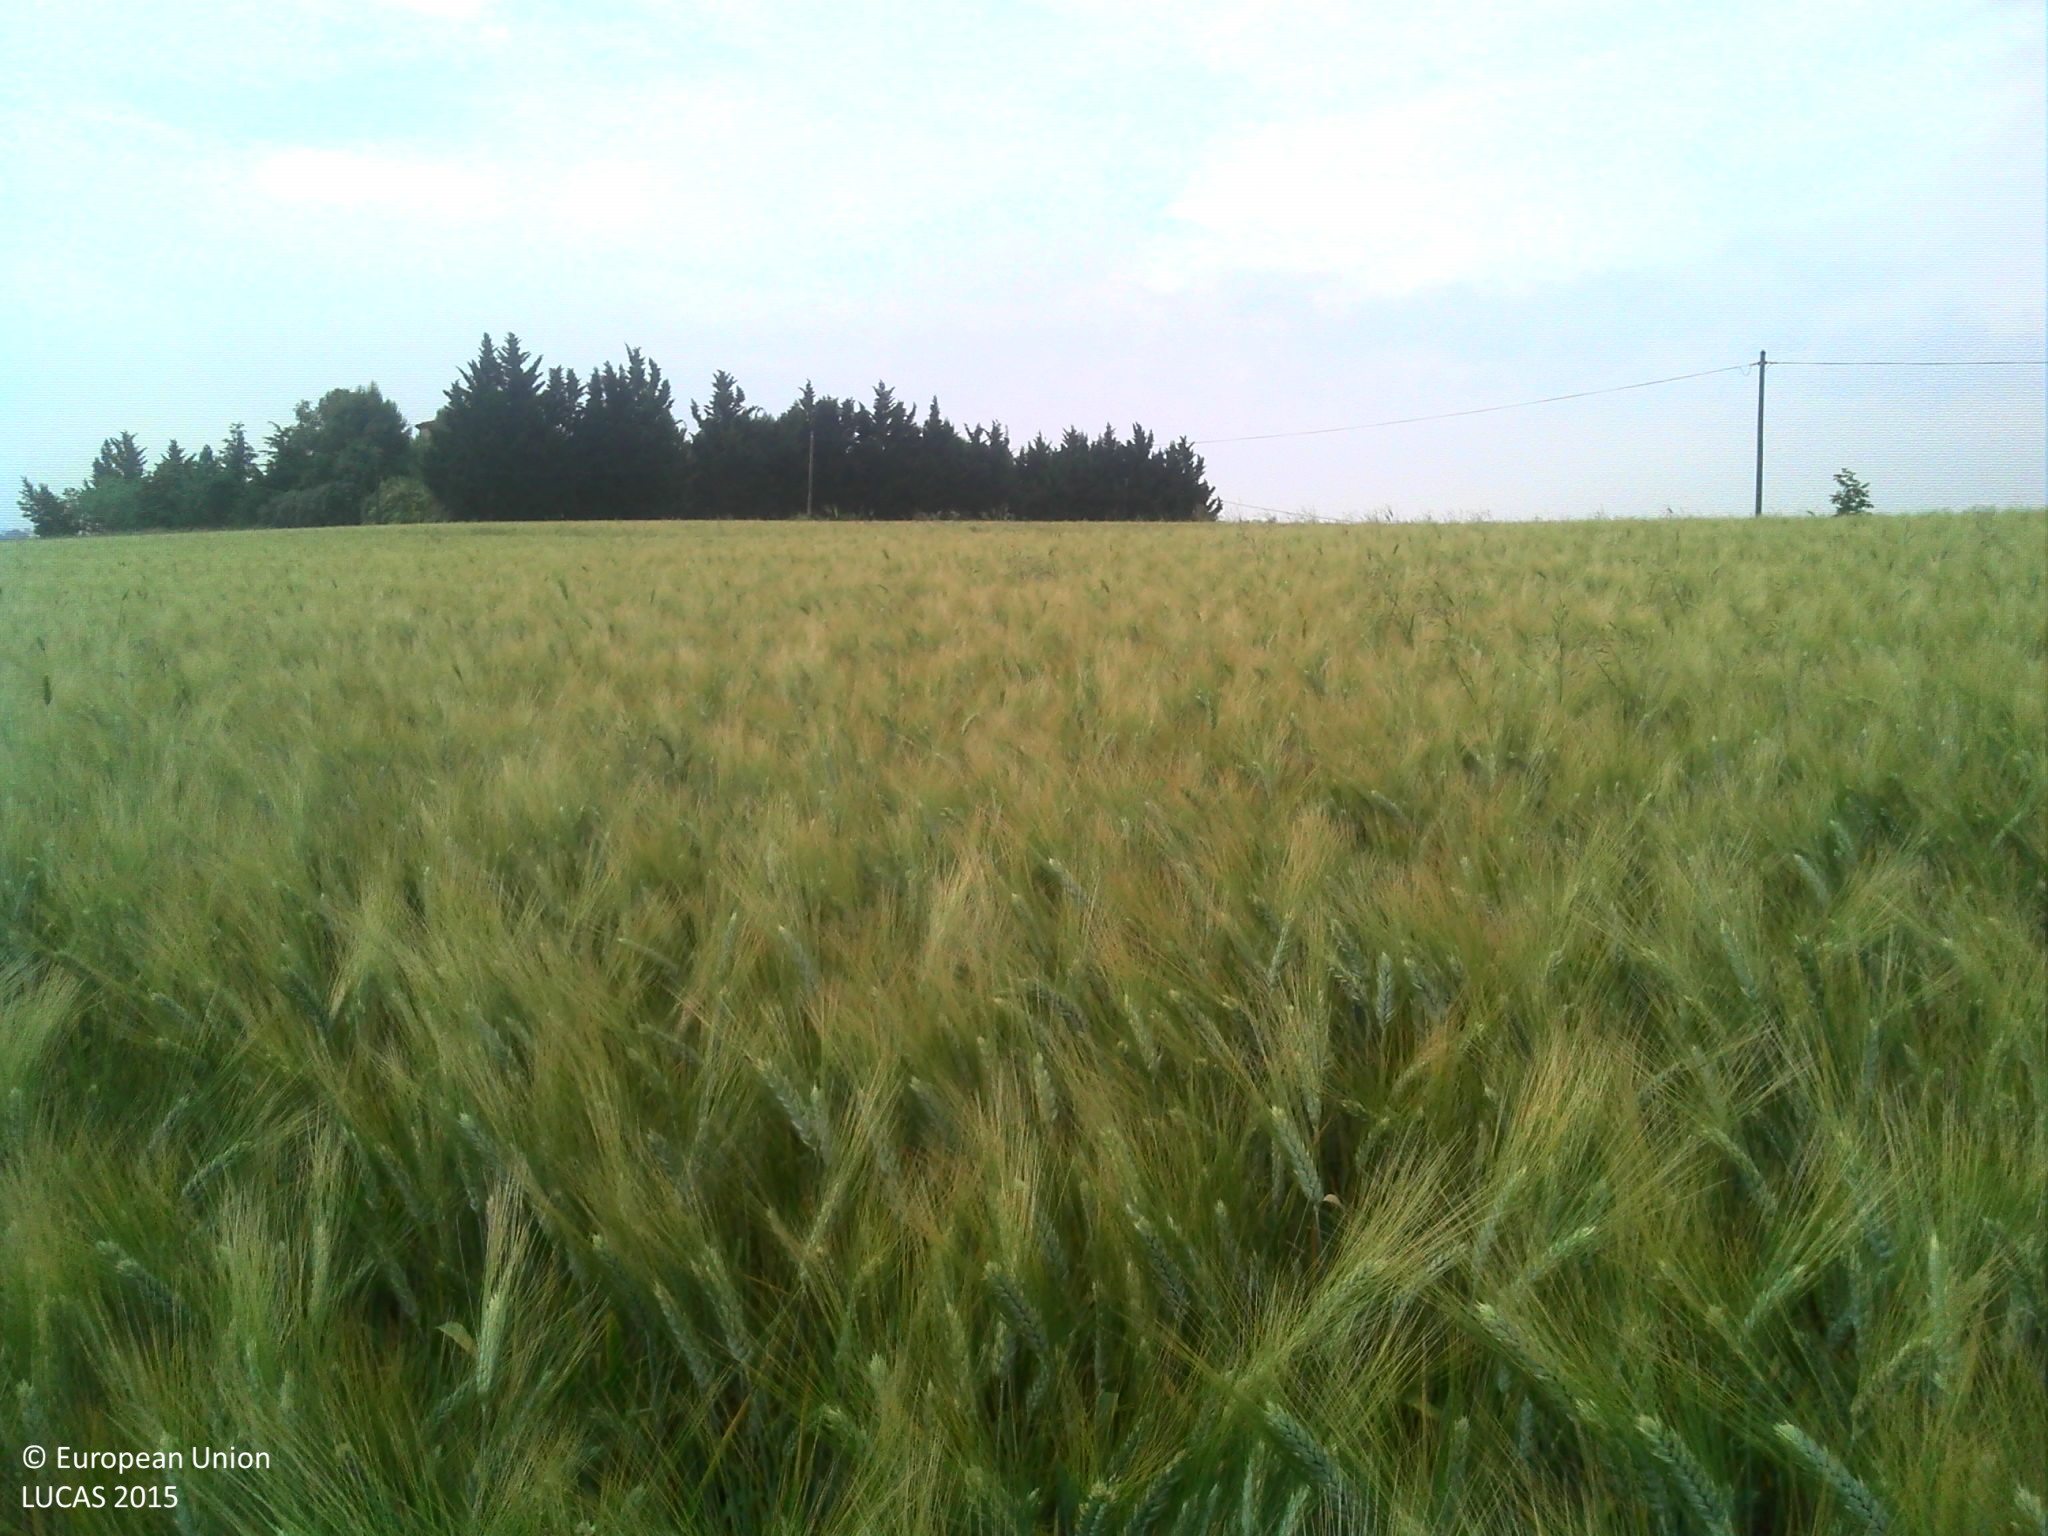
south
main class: Cropland
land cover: Common wheat
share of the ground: > 75 %
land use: Agriculture (excluding fallow land and kitchen gardens)
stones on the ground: 10 - 25 %
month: June
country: FR
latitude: 43.6888
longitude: 2.1270
